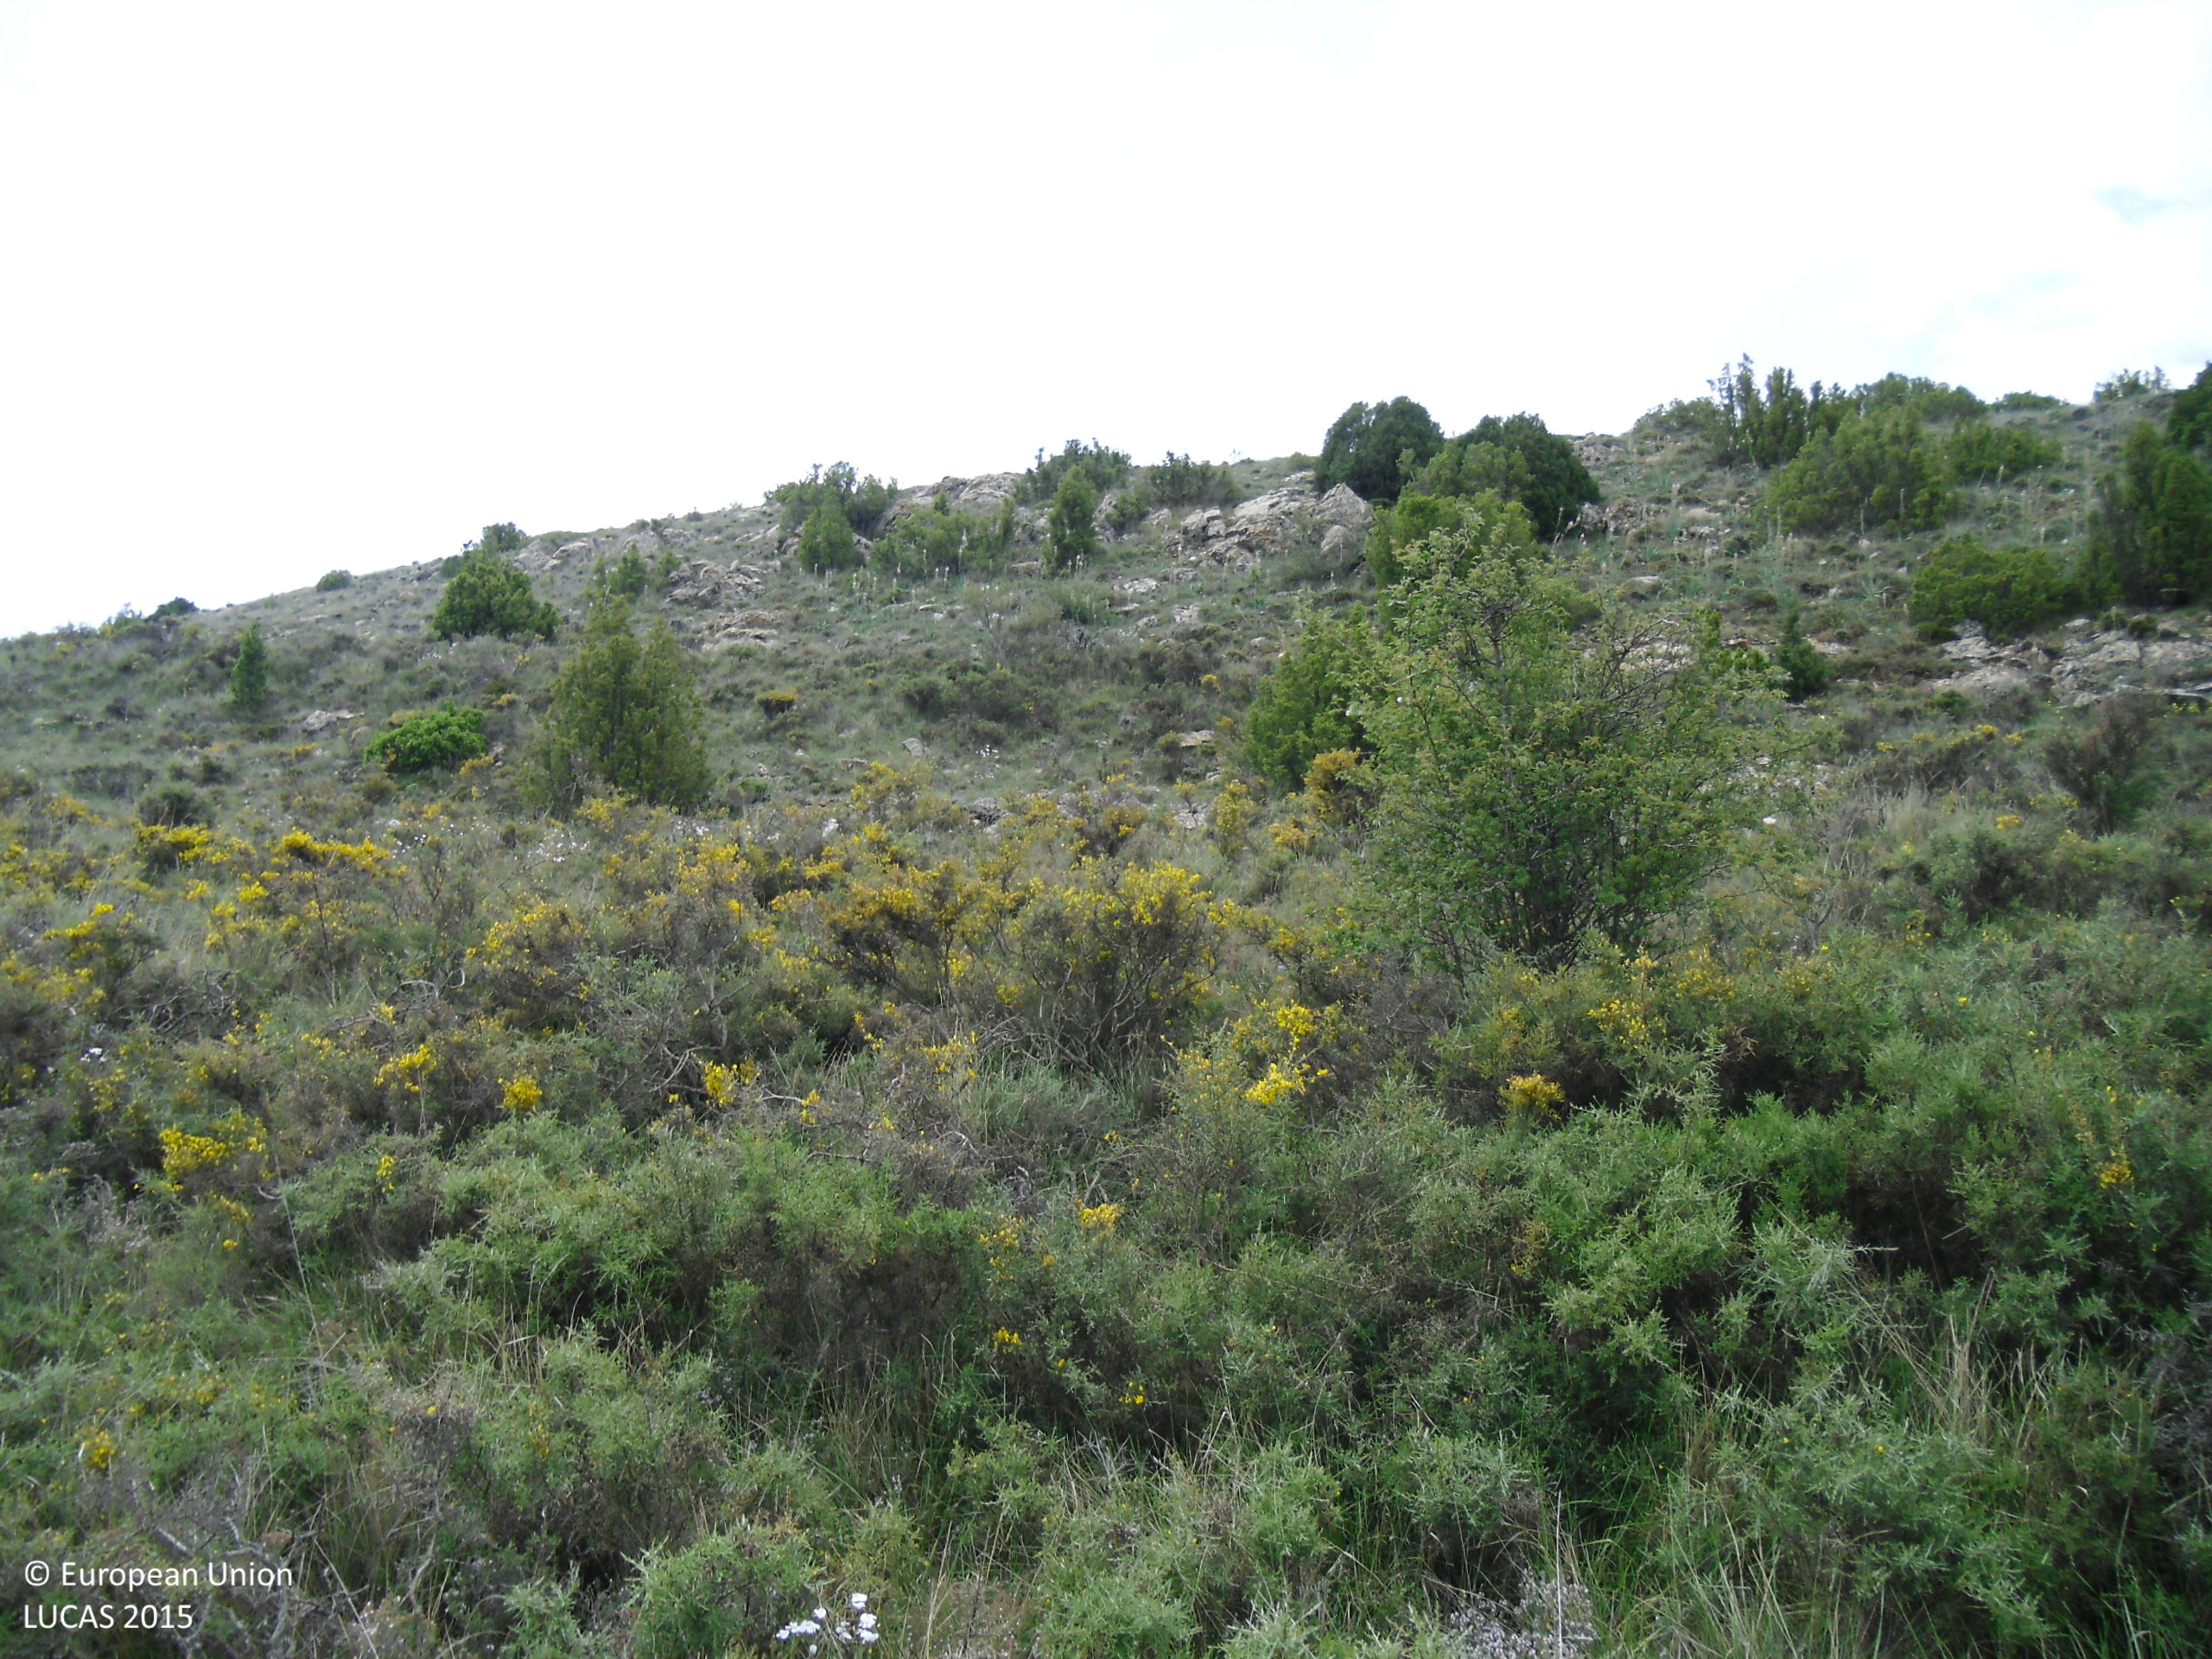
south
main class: Shrubland
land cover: Shrubland without tree cover
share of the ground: > 75 %
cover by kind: shrubs 80 %, herbaceous plants 20 %
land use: Agriculture (excluding fallow land and kitchen gardens)
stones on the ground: < 10 %
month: May
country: ES
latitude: 40.8828
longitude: -0.8732
